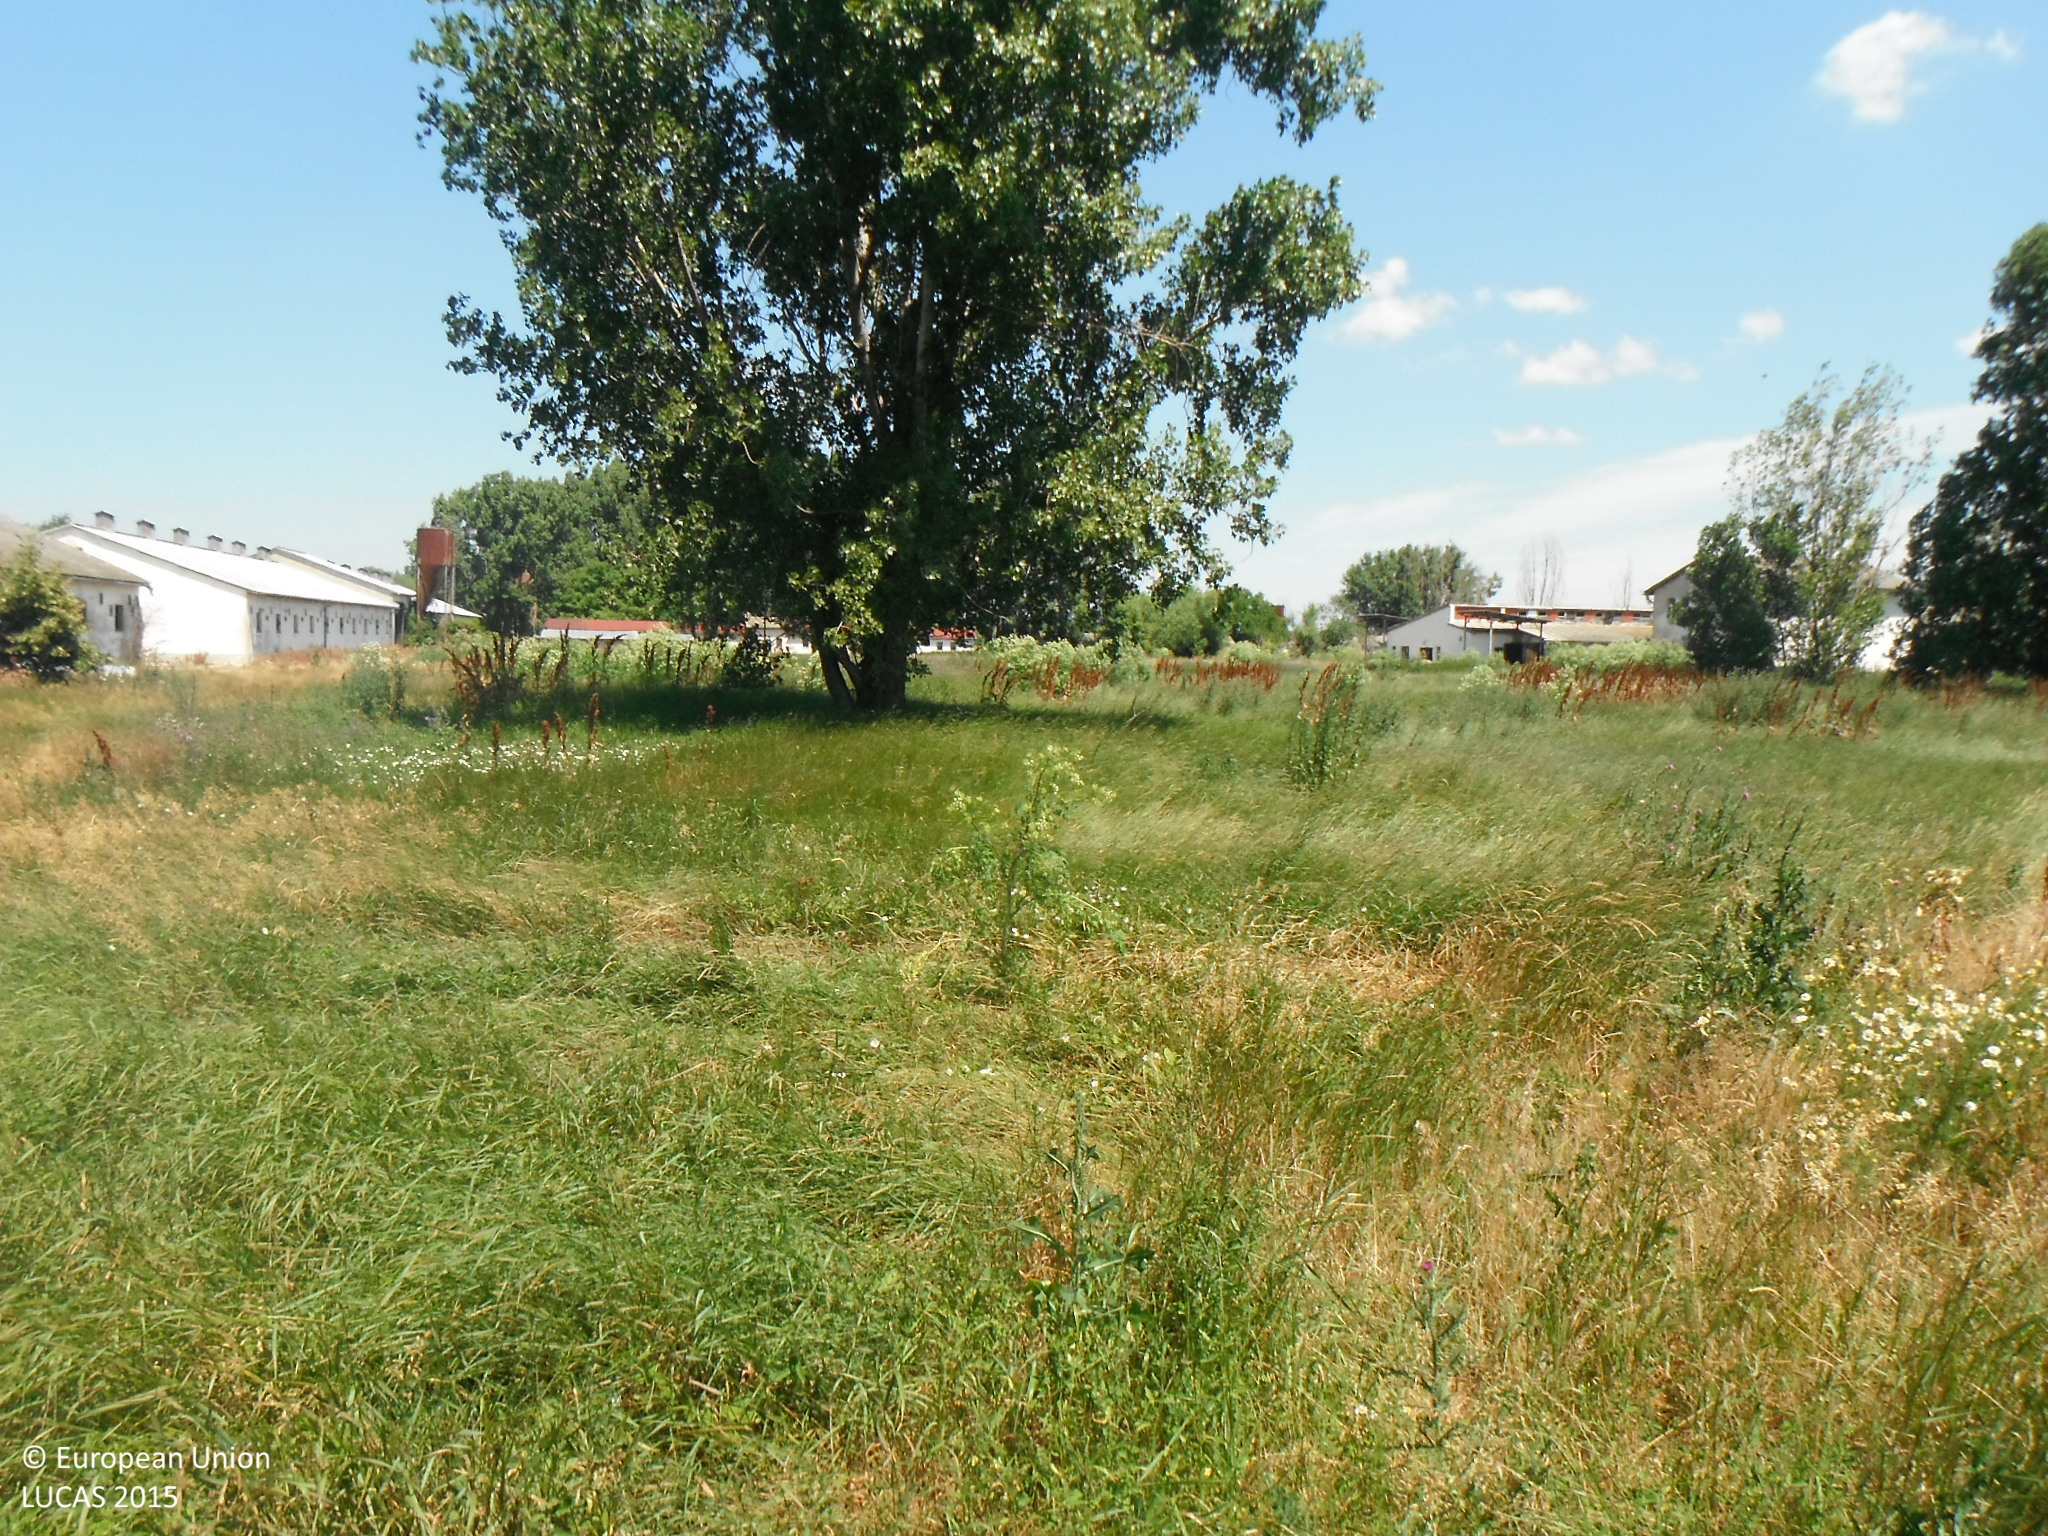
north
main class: Grassland
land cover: Spontaneously vegetated surfaces
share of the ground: > 75 %
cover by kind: herbaceous plants 100 %
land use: Abandoned areas
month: June
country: SK
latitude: 47.8470
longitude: 18.1778
